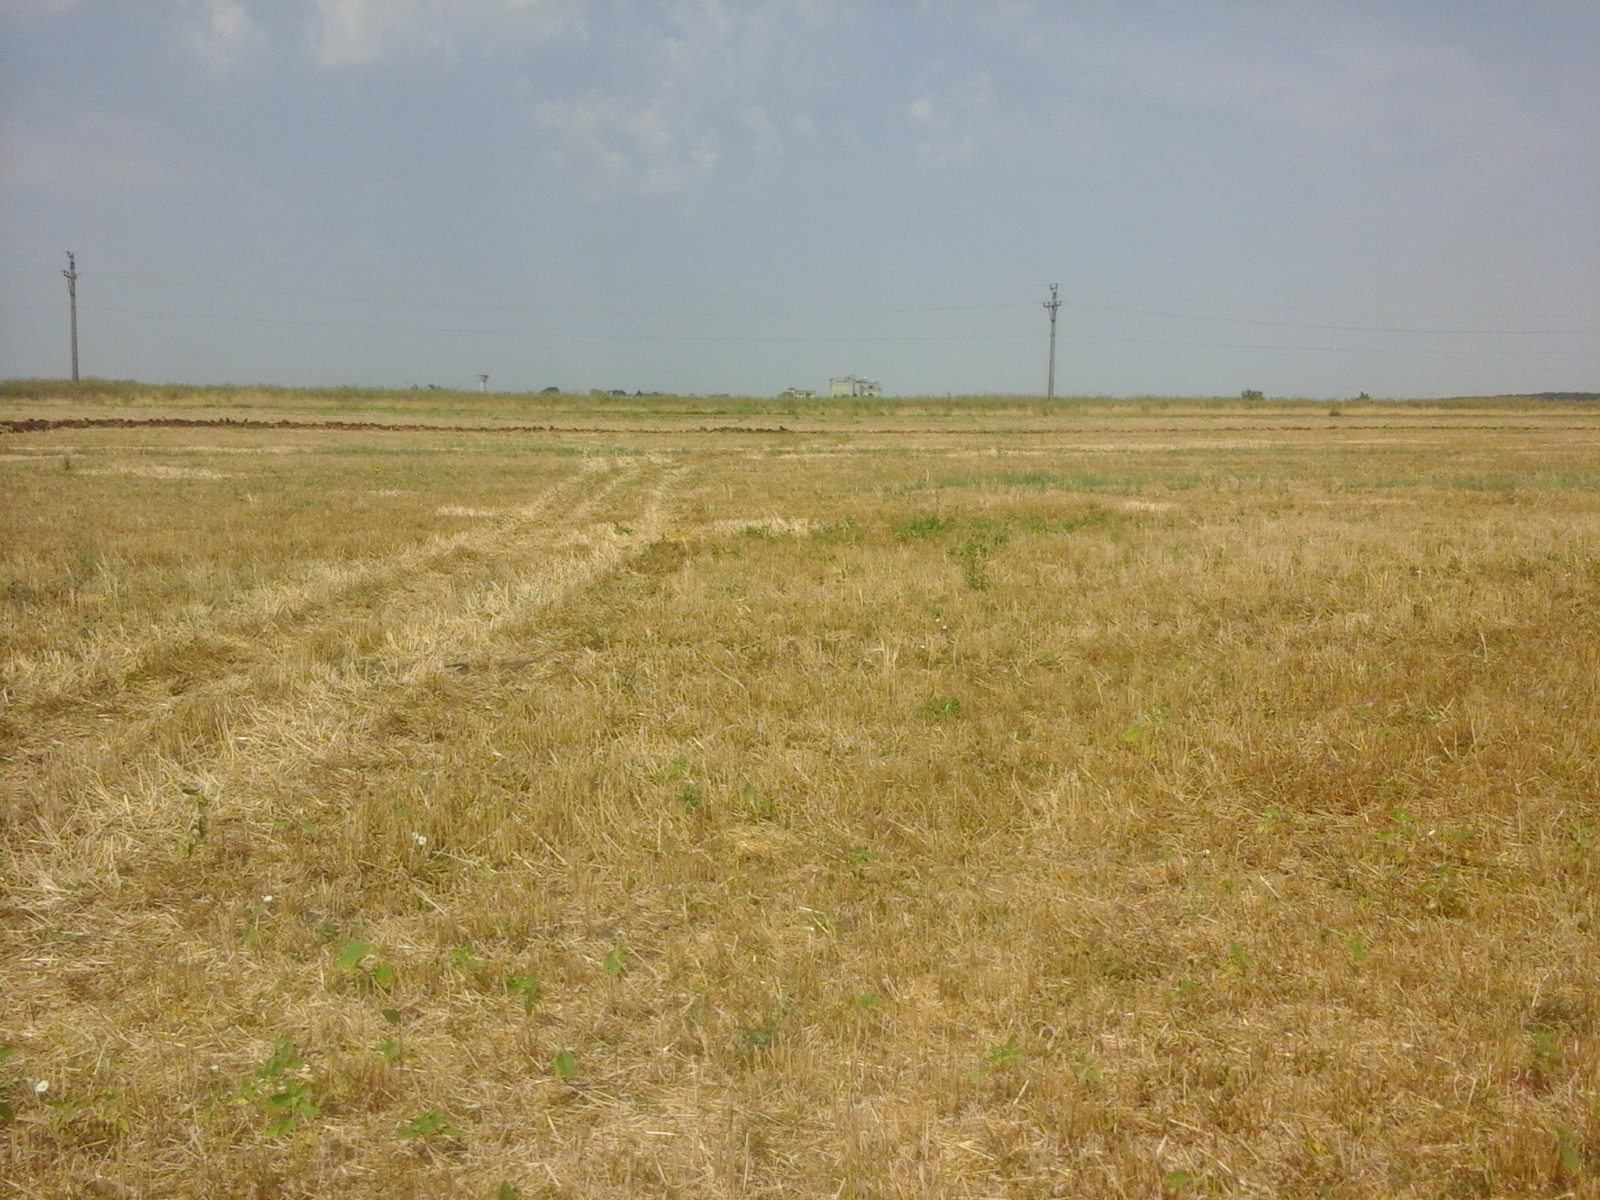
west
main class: Cropland
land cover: Barley
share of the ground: > 75 %
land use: Agriculture (excluding fallow land and kitchen gardens)
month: August
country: RO
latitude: 44.1052
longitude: 23.7590
